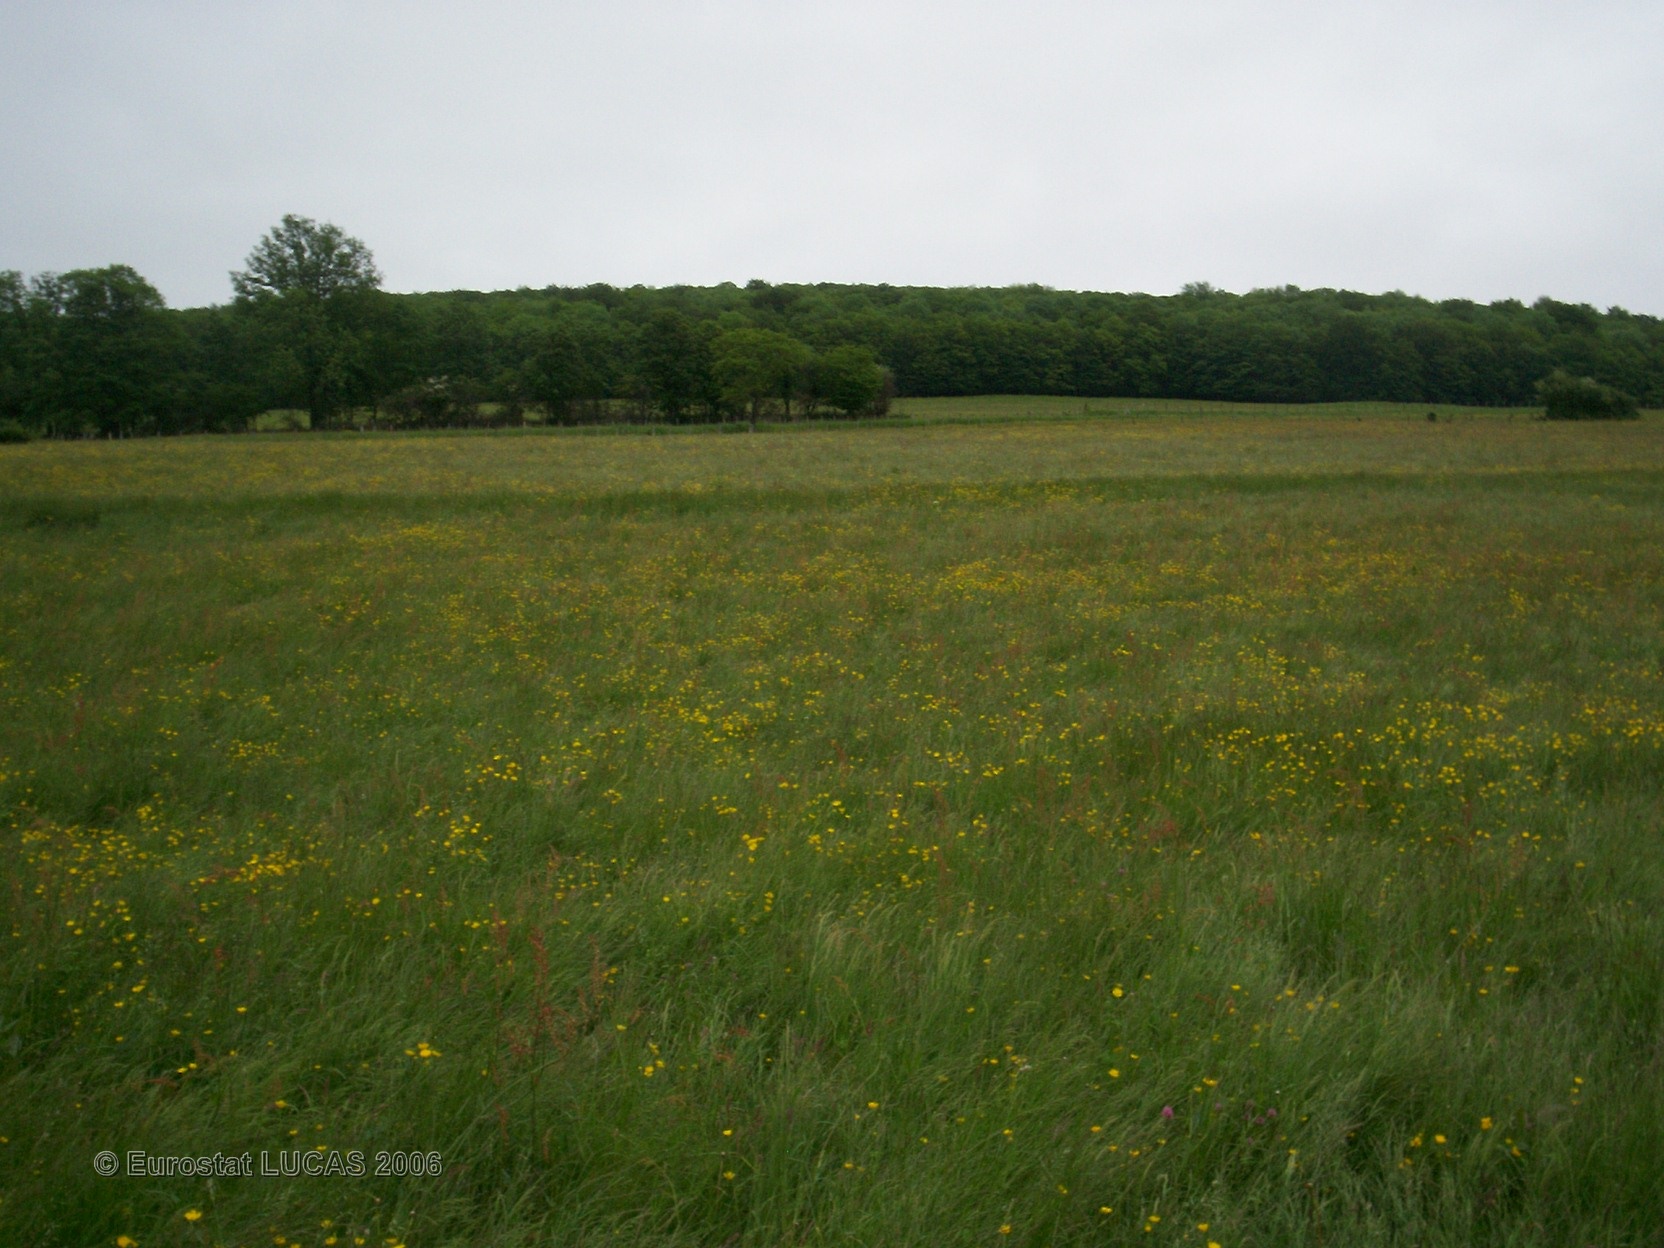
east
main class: Grassland
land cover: Grassland without tree/shrub cover
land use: Agriculture (excluding fallow land and kitchen gardens)
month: May
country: FR
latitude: 47.3728
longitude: 4.6626
